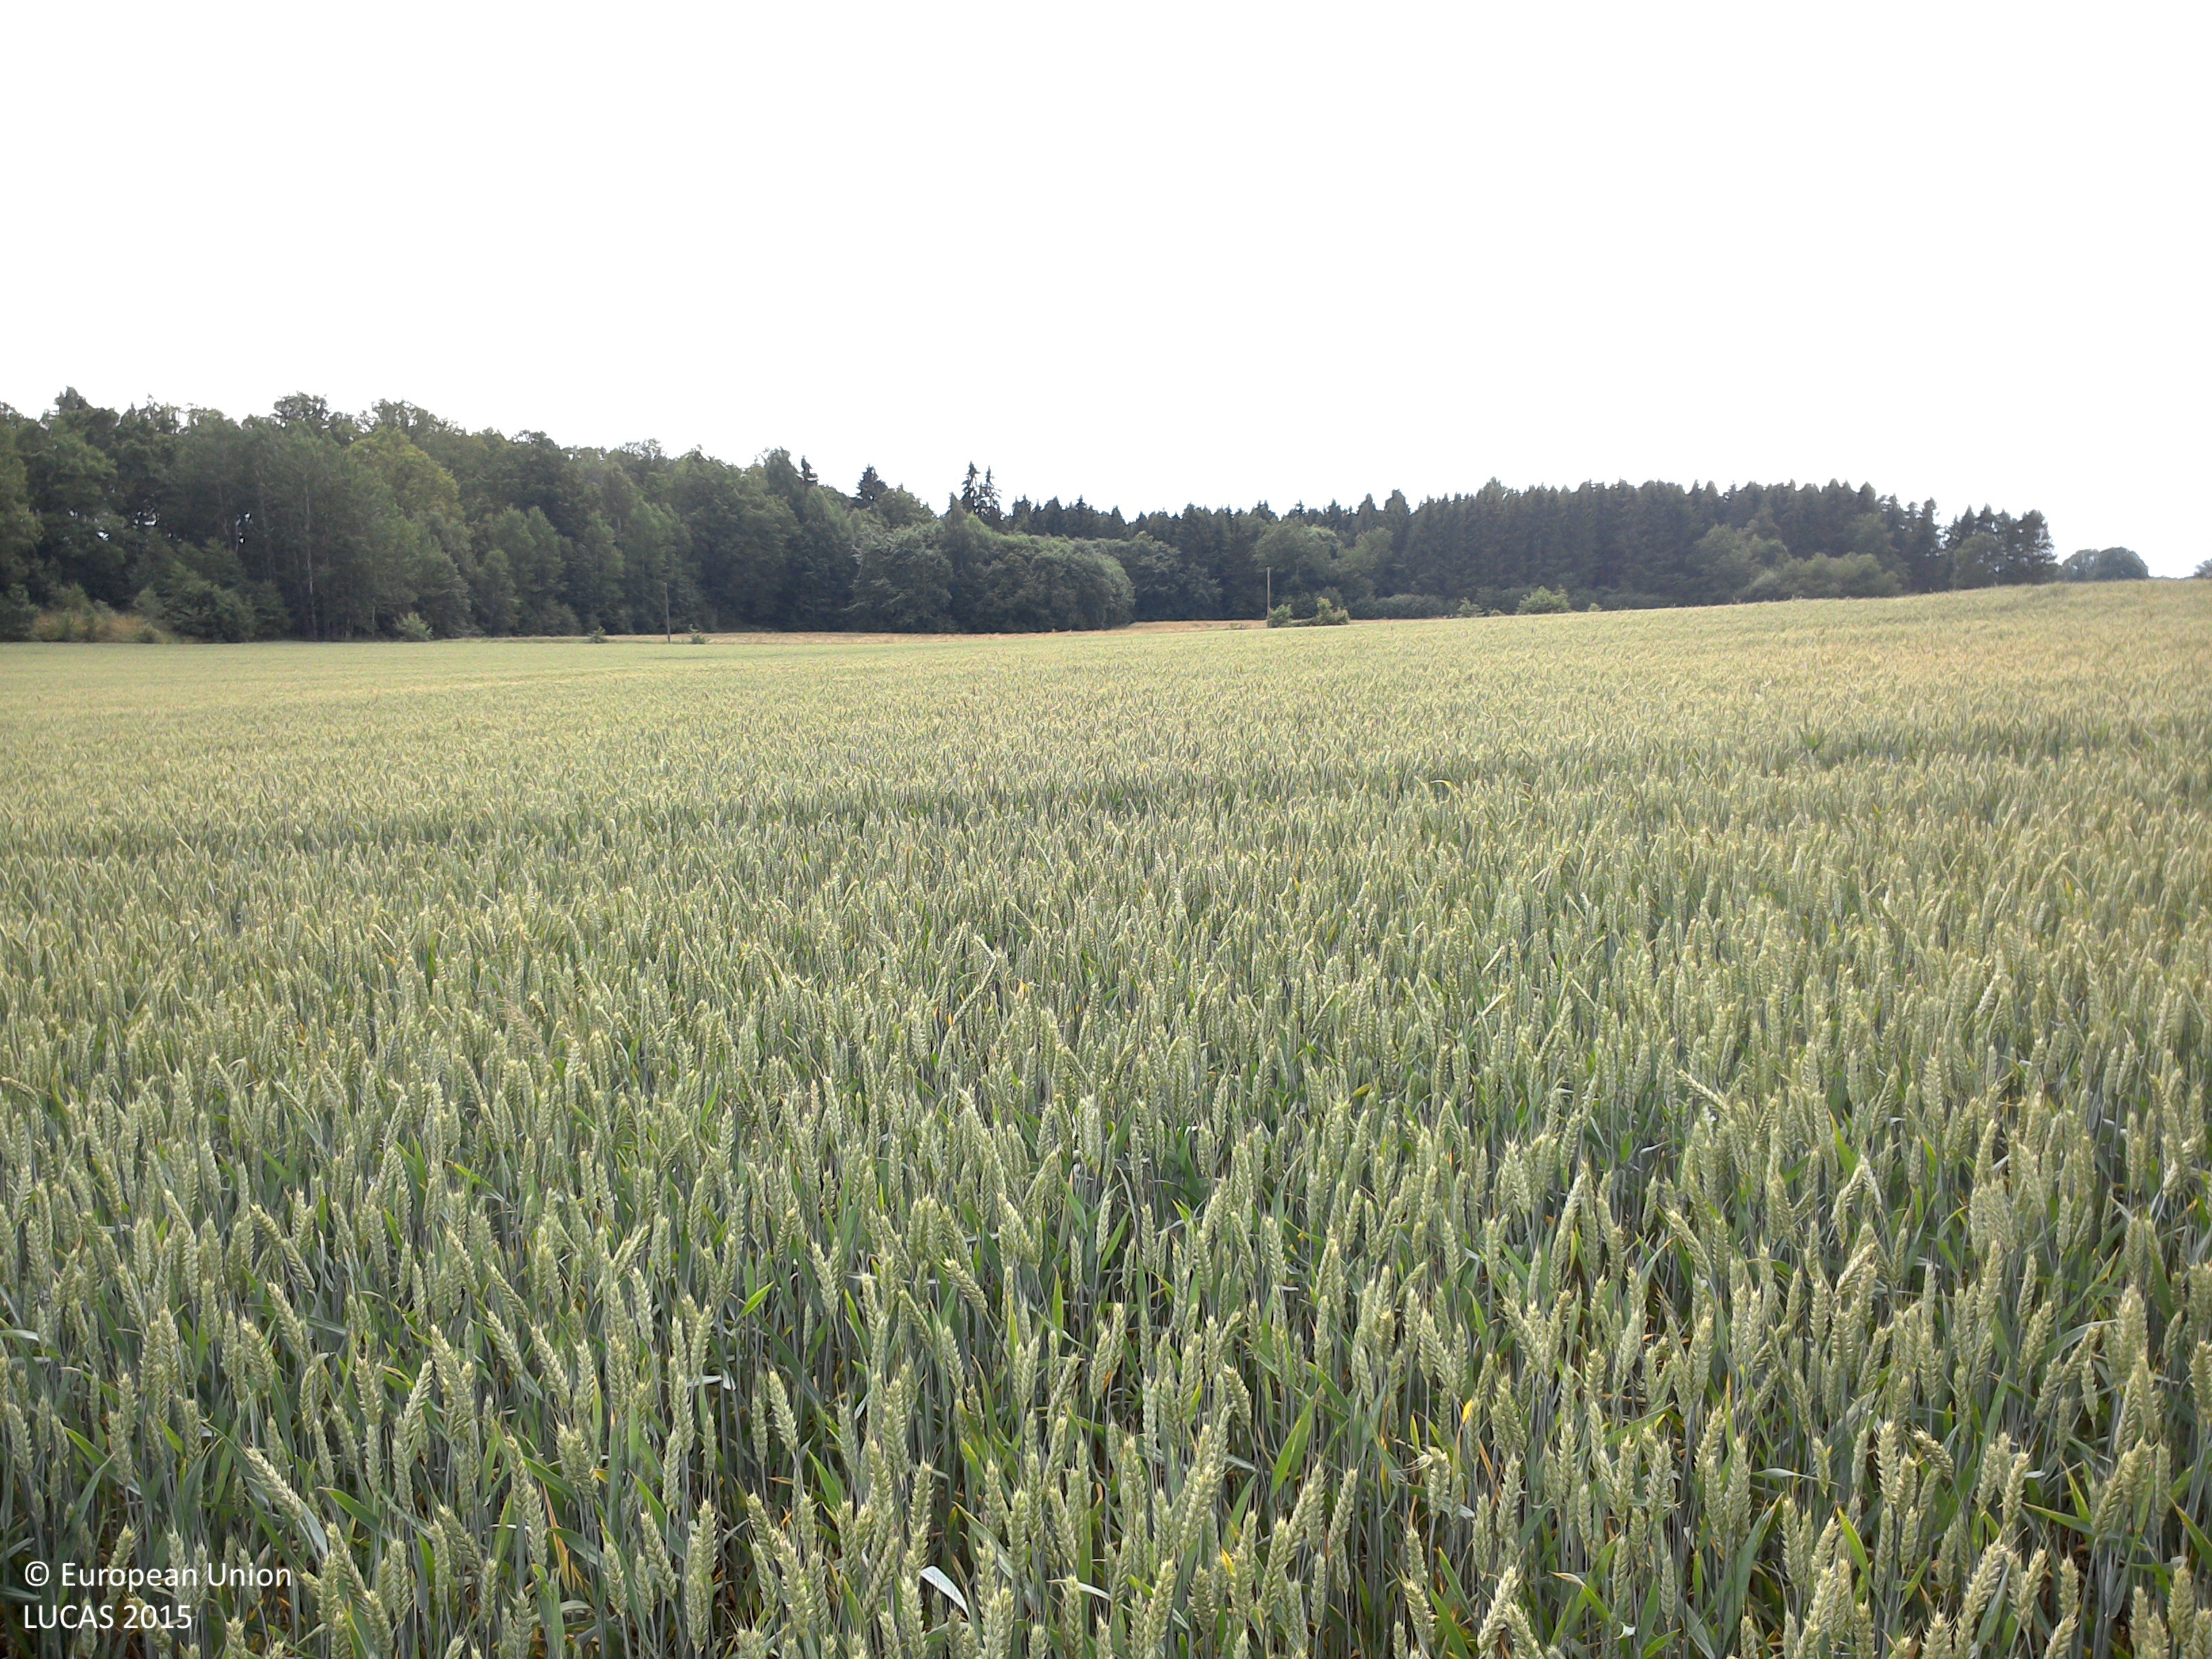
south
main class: Cropland
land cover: Common wheat
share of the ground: > 75 %
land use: Agriculture (excluding fallow land and kitchen gardens)
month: July
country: SE
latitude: 58.2630
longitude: 14.7154
